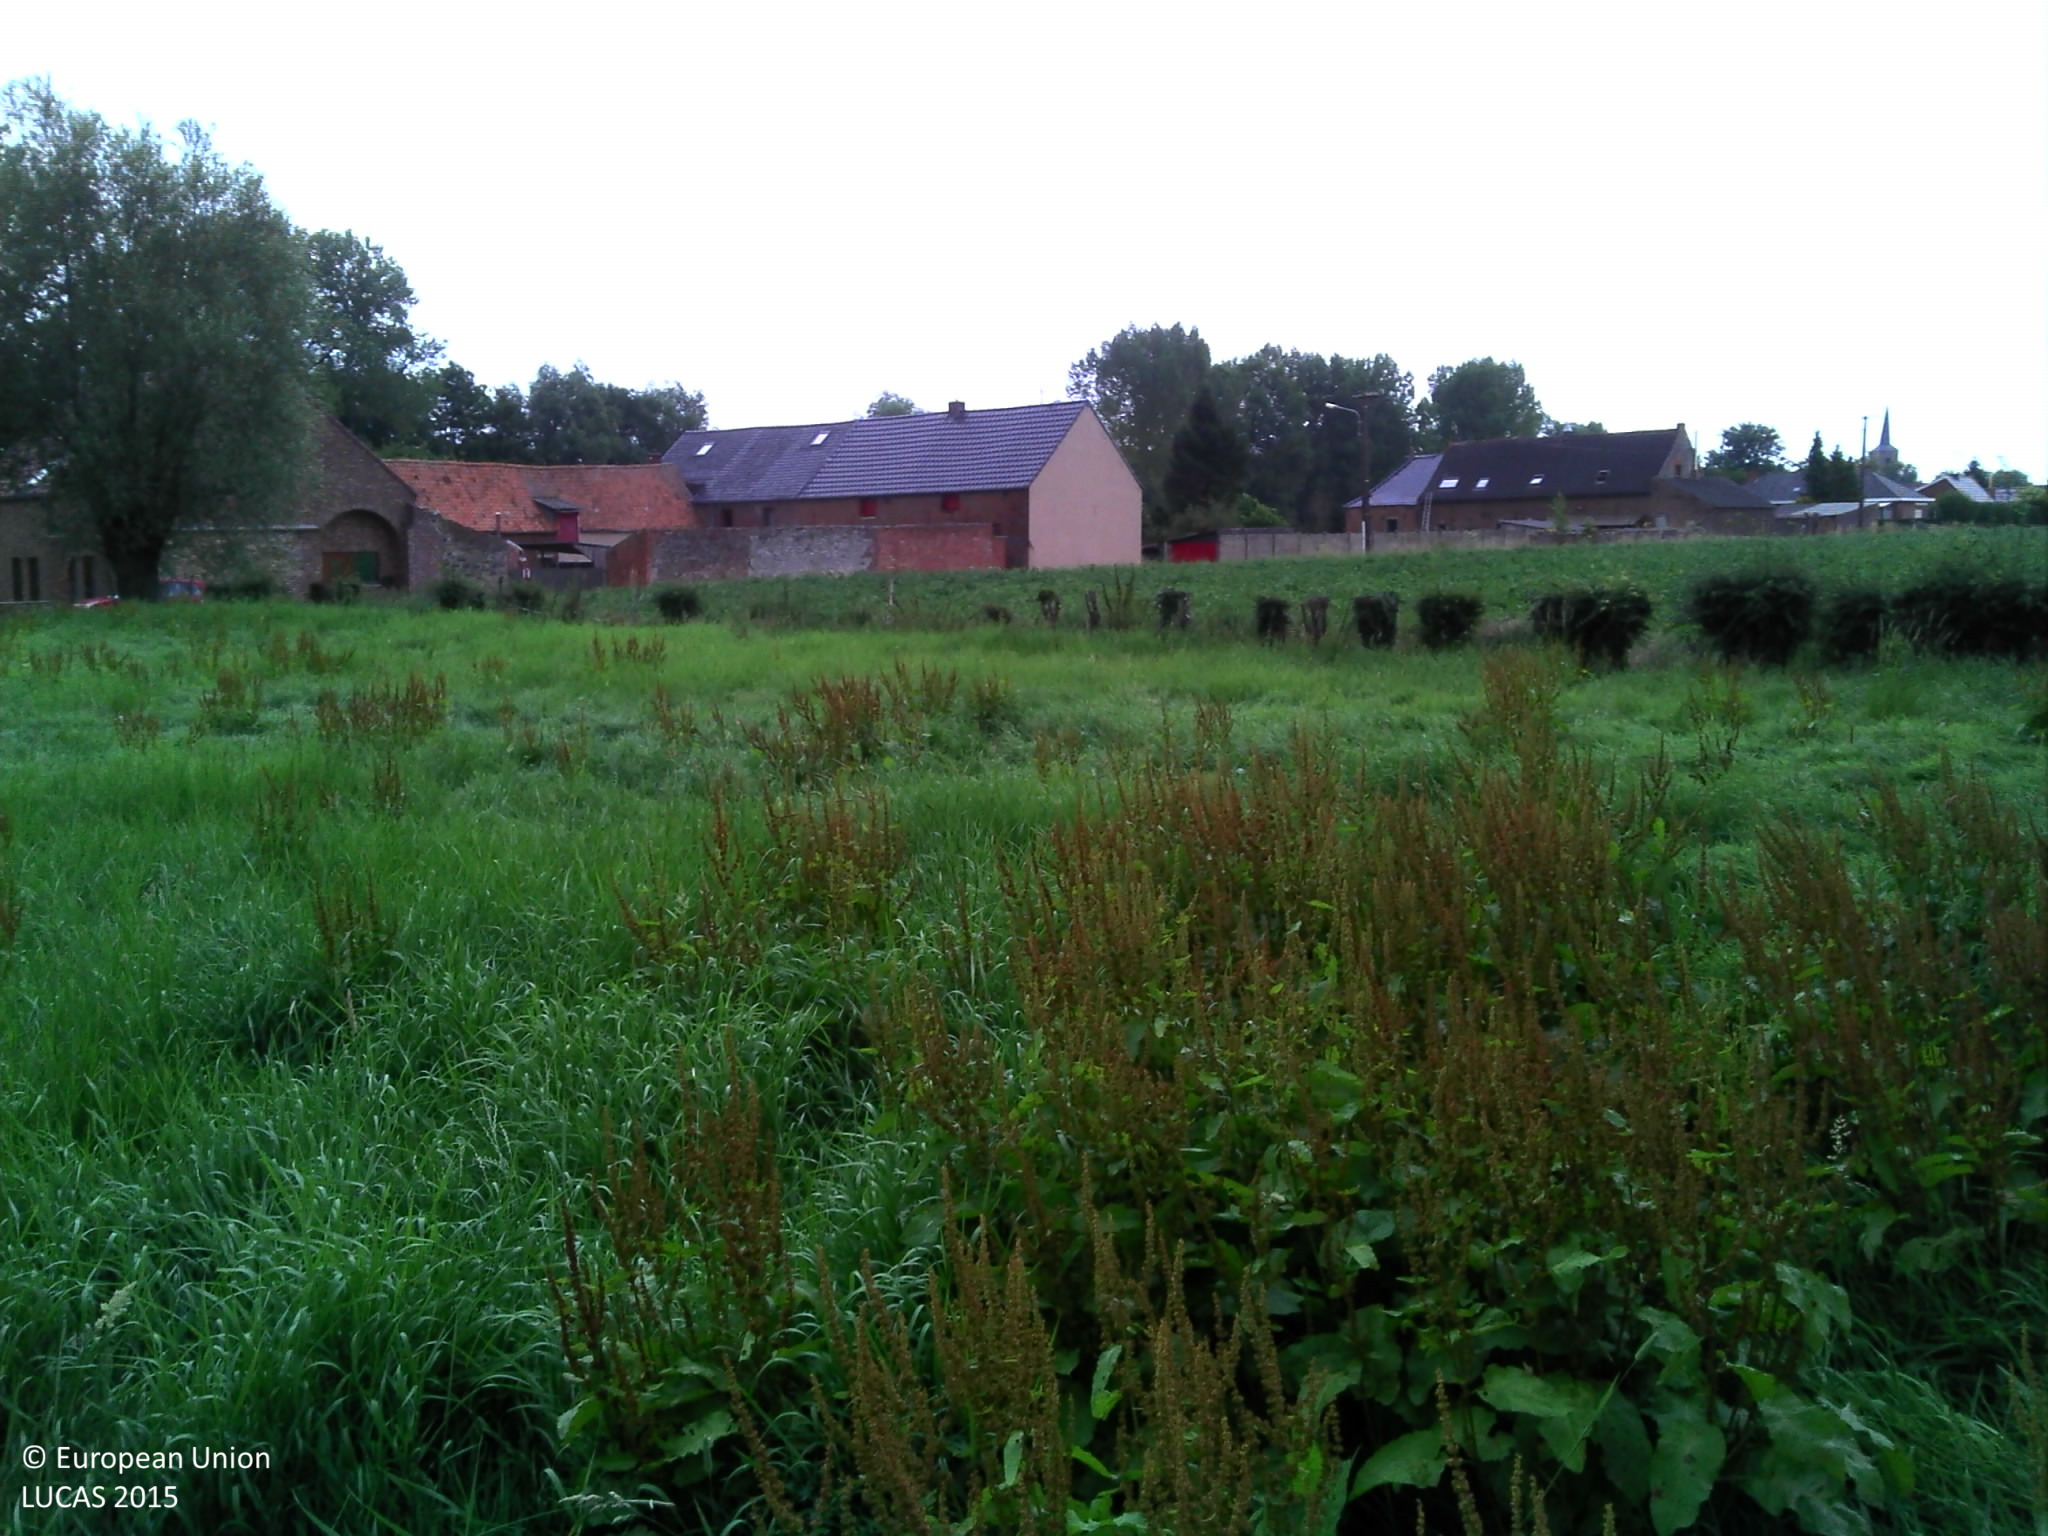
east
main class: Grassland
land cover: Grassland without tree/shrub cover
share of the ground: > 75 %
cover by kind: herbaceous plants 100 %
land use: Agriculture (excluding fallow land and kitchen gardens)
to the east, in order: Grassland without tree/shrub cover; Fences; Ditches and canals; Grass margins; Potatoes; Grass margins; Ditches and canals; Artificial constructions in urban areas; Grassland without tree/shrub cover; Broadleaved woodland; Rivers and streams; Grassland without tree/shrub cover
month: August
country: BE
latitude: 50.6653
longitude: 3.8108
